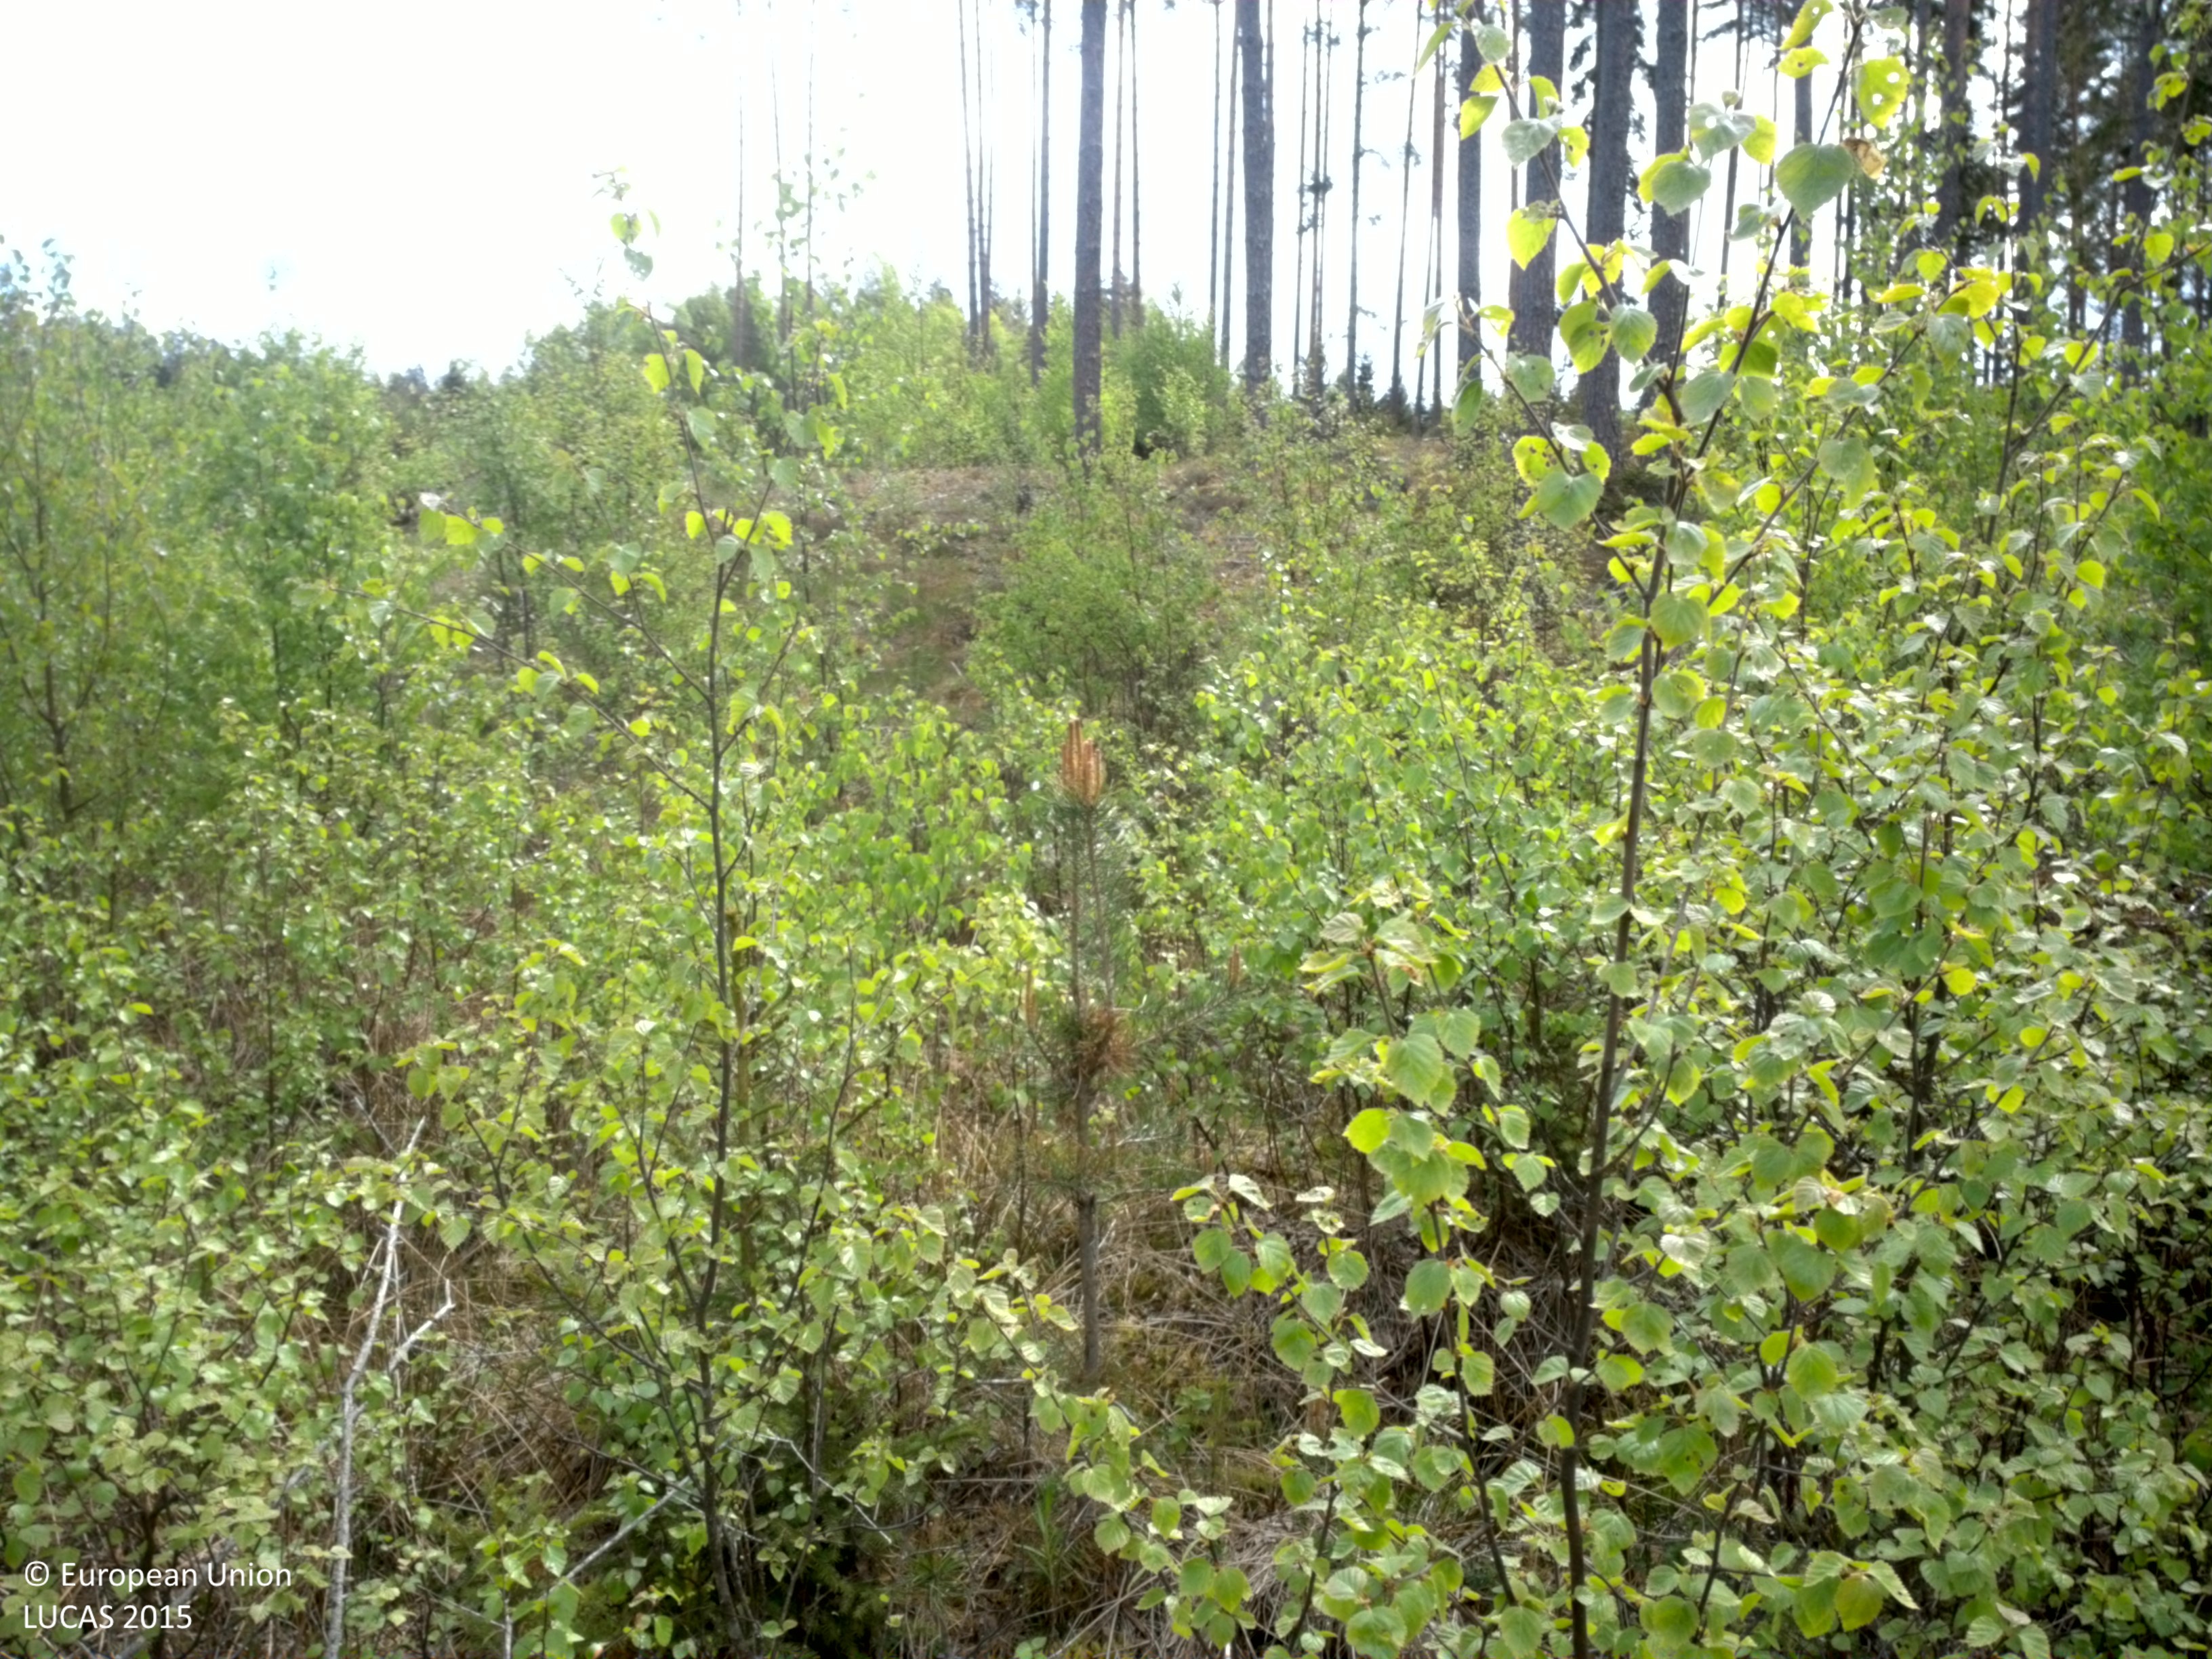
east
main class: Woodland
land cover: Broadleaved woodland
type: hemiboreal forest and nemoral coniferous forest and mixed broadleaved-coniferous forest
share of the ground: > 75 %
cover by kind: broadleaved forest trees 80 %, coniferous forest trees 10 %, shrubs 10 %
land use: Forestry
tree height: < 5 m
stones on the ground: < 10 %
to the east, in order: Broadleaved woodland; Pine dominated coniferous woodland; Broadleaved woodland; Ditches and canals; Broadleaved woodland; Spruce dominated coniferous woodland; Ditches and canals; Spruce dominated coniferous woodland; Pine dominated coniferous woodland
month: May
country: SE
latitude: 56.5156
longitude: 15.1828
